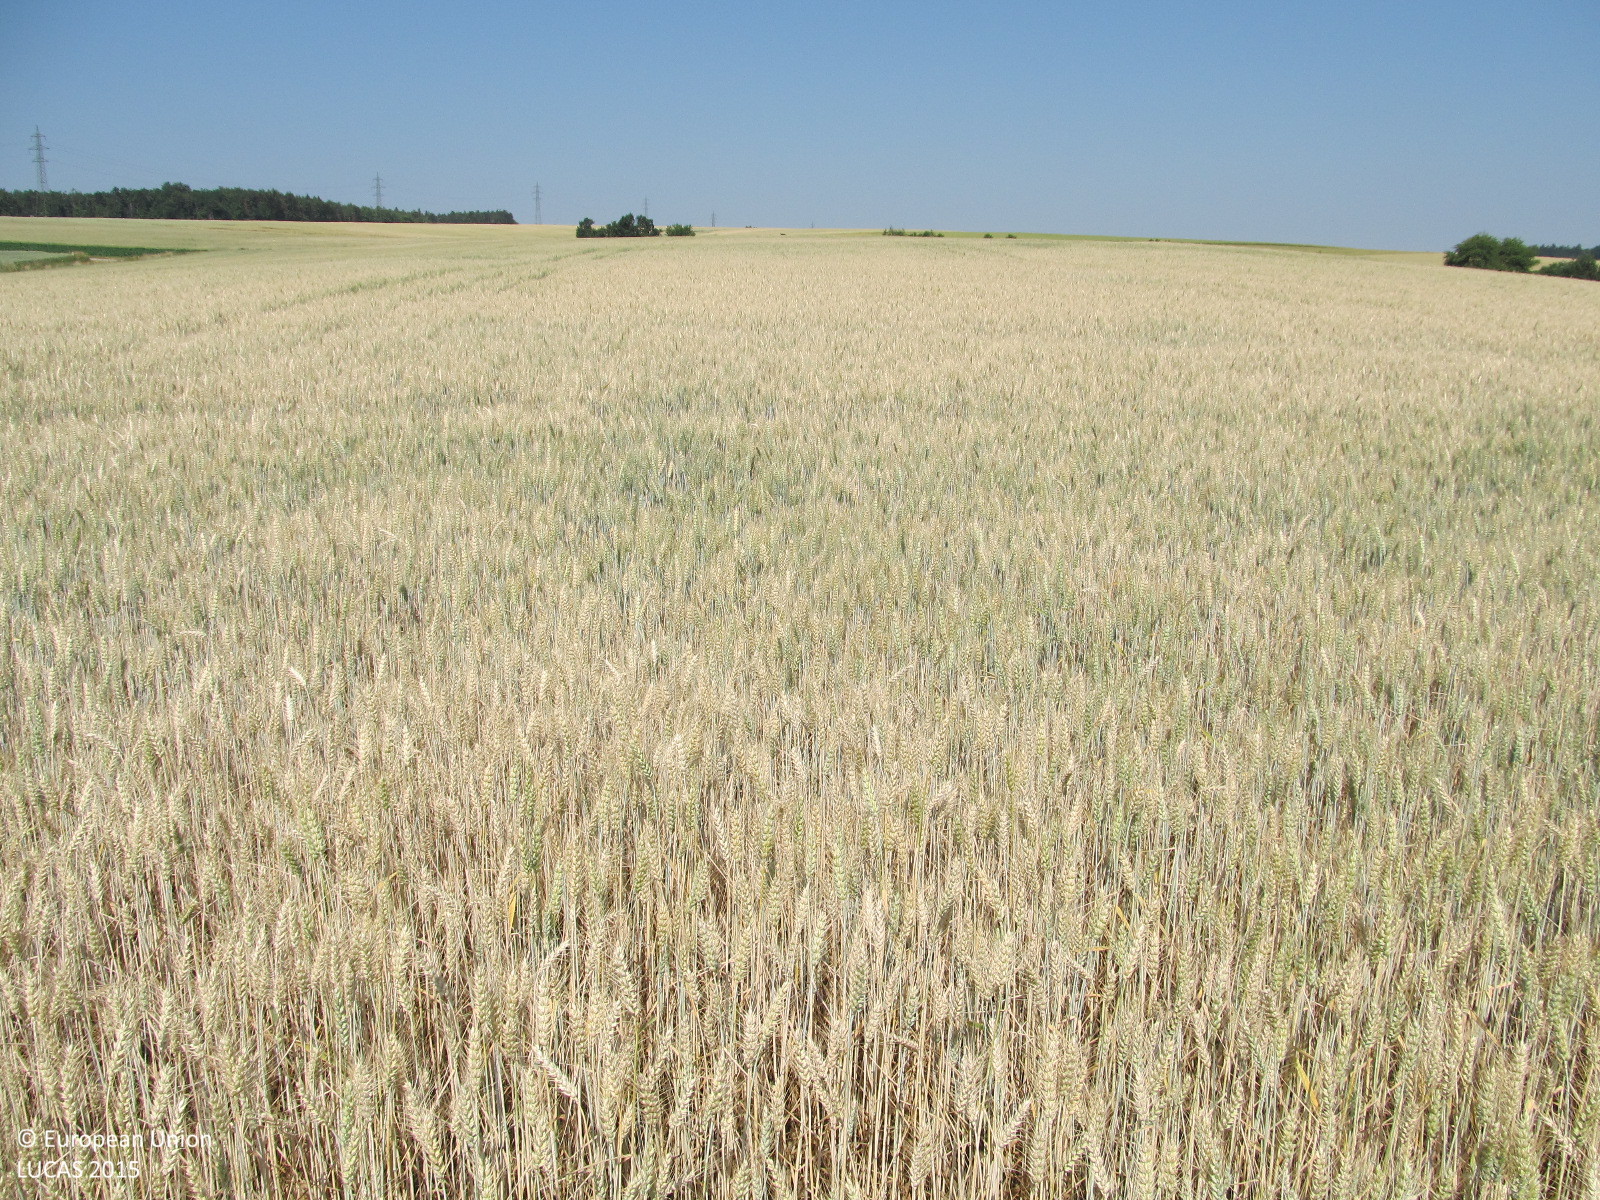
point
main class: Cropland
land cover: Common wheat
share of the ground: > 75 %
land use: Agriculture (excluding fallow land and kitchen gardens)
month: July
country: AT
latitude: 48.7268
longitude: 15.6724
